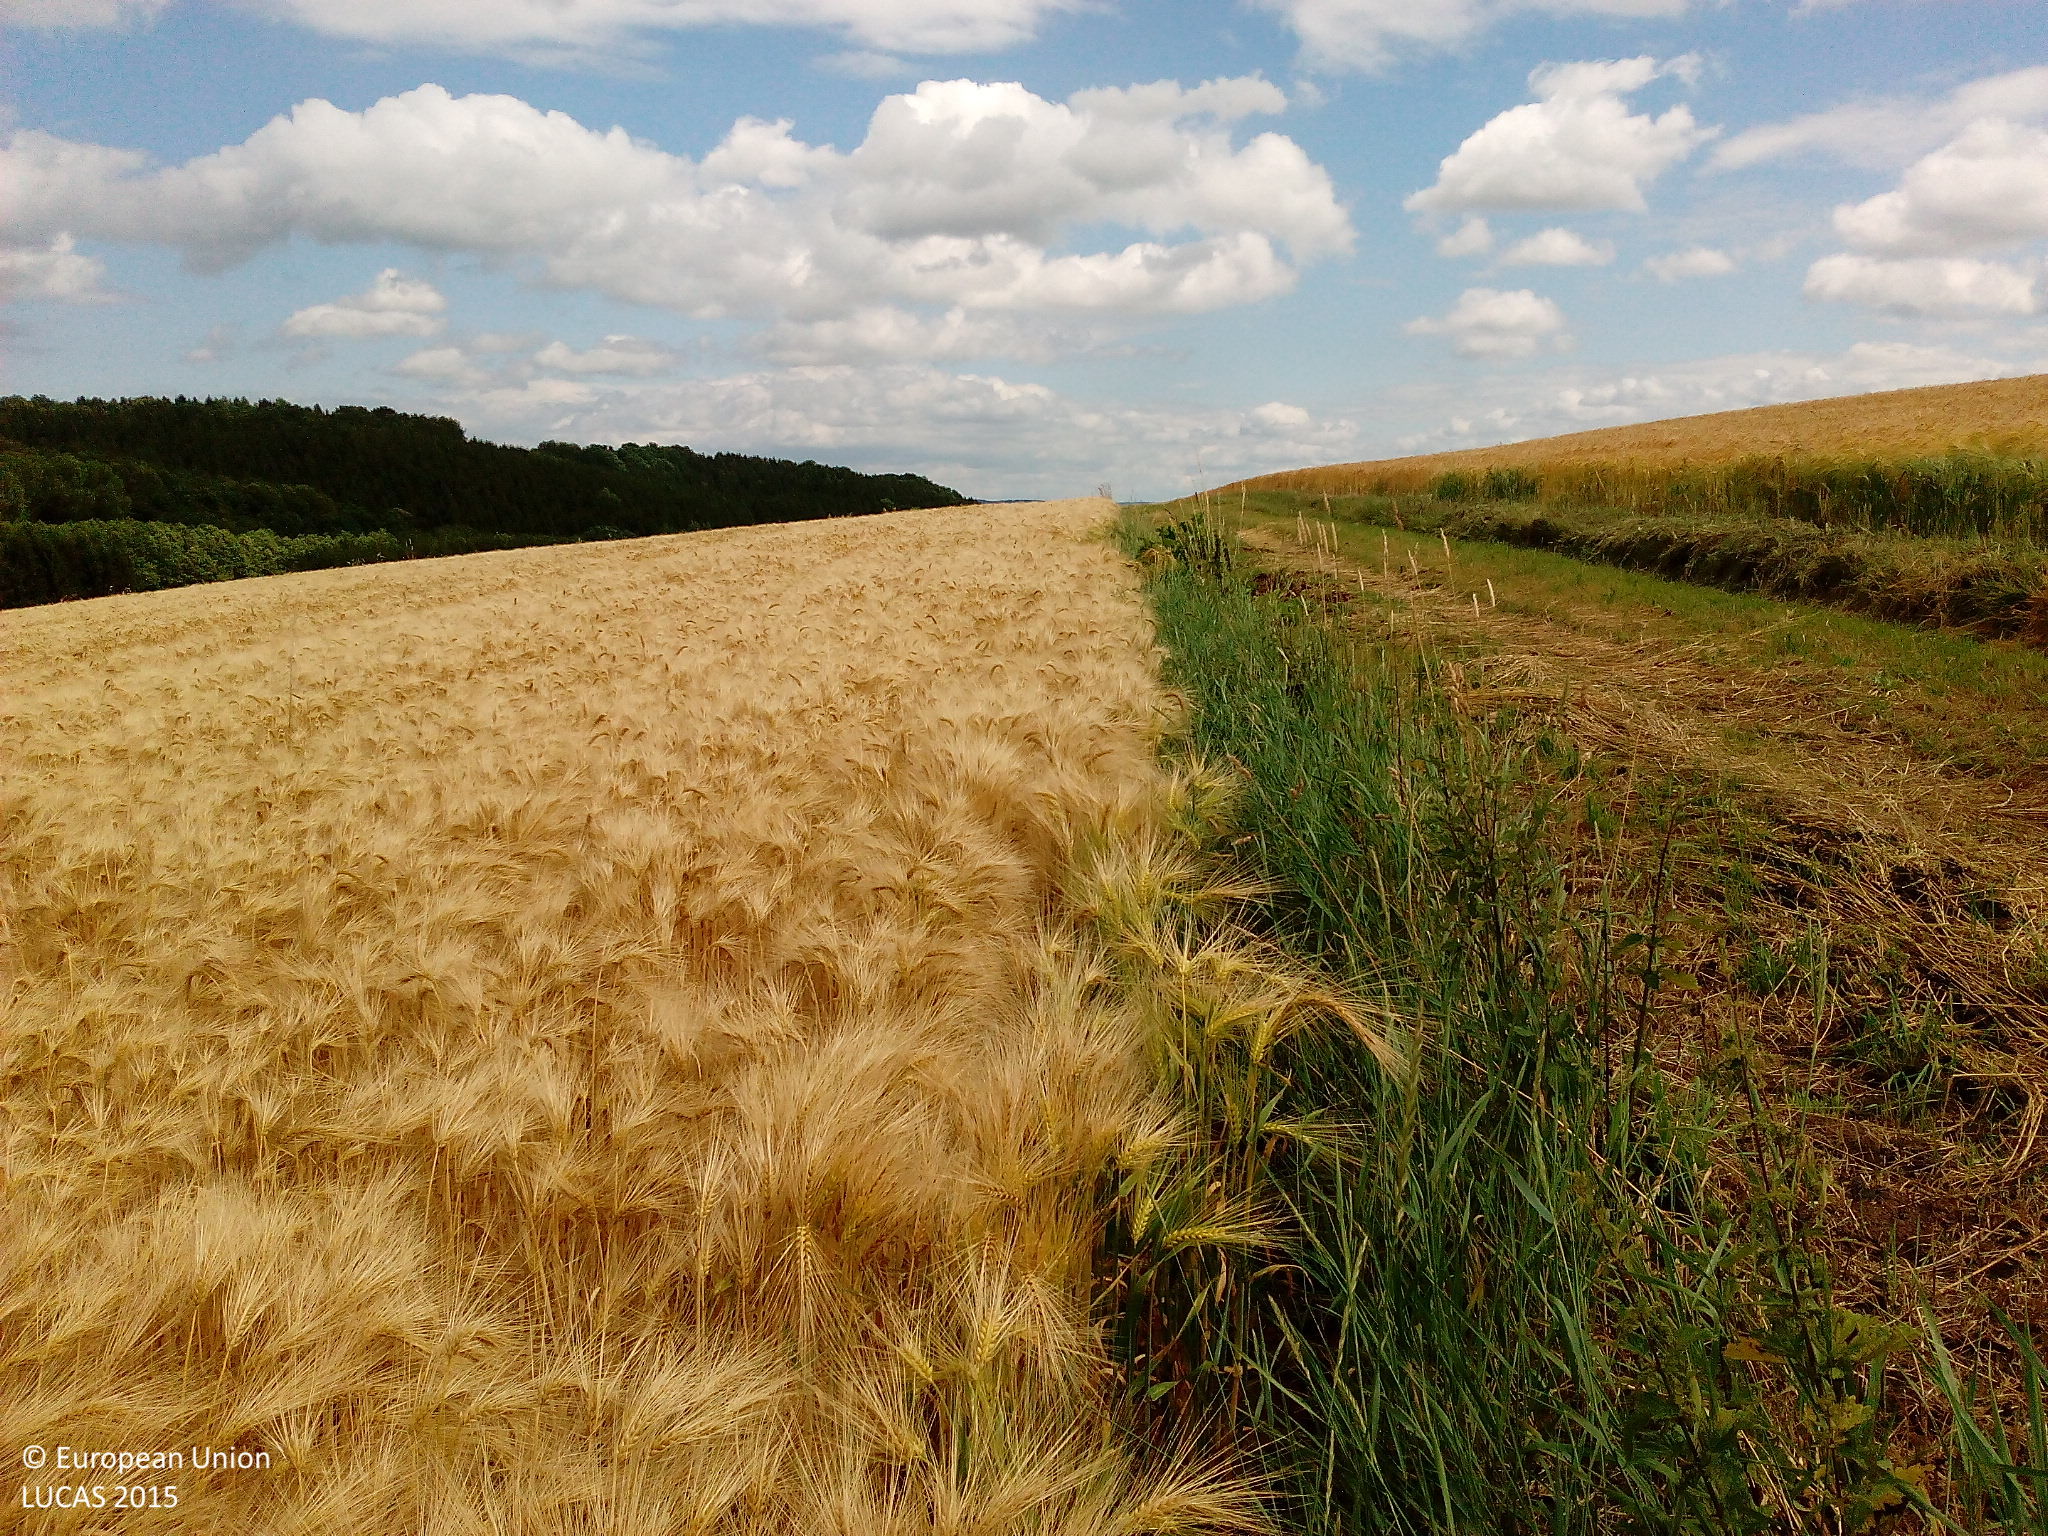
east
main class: Cropland
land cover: Barley
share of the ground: > 75 %
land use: Agriculture (excluding fallow land and kitchen gardens)
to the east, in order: Barley; Rape and turnip rape
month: July
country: DE
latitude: 51.0651
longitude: 9.8431
